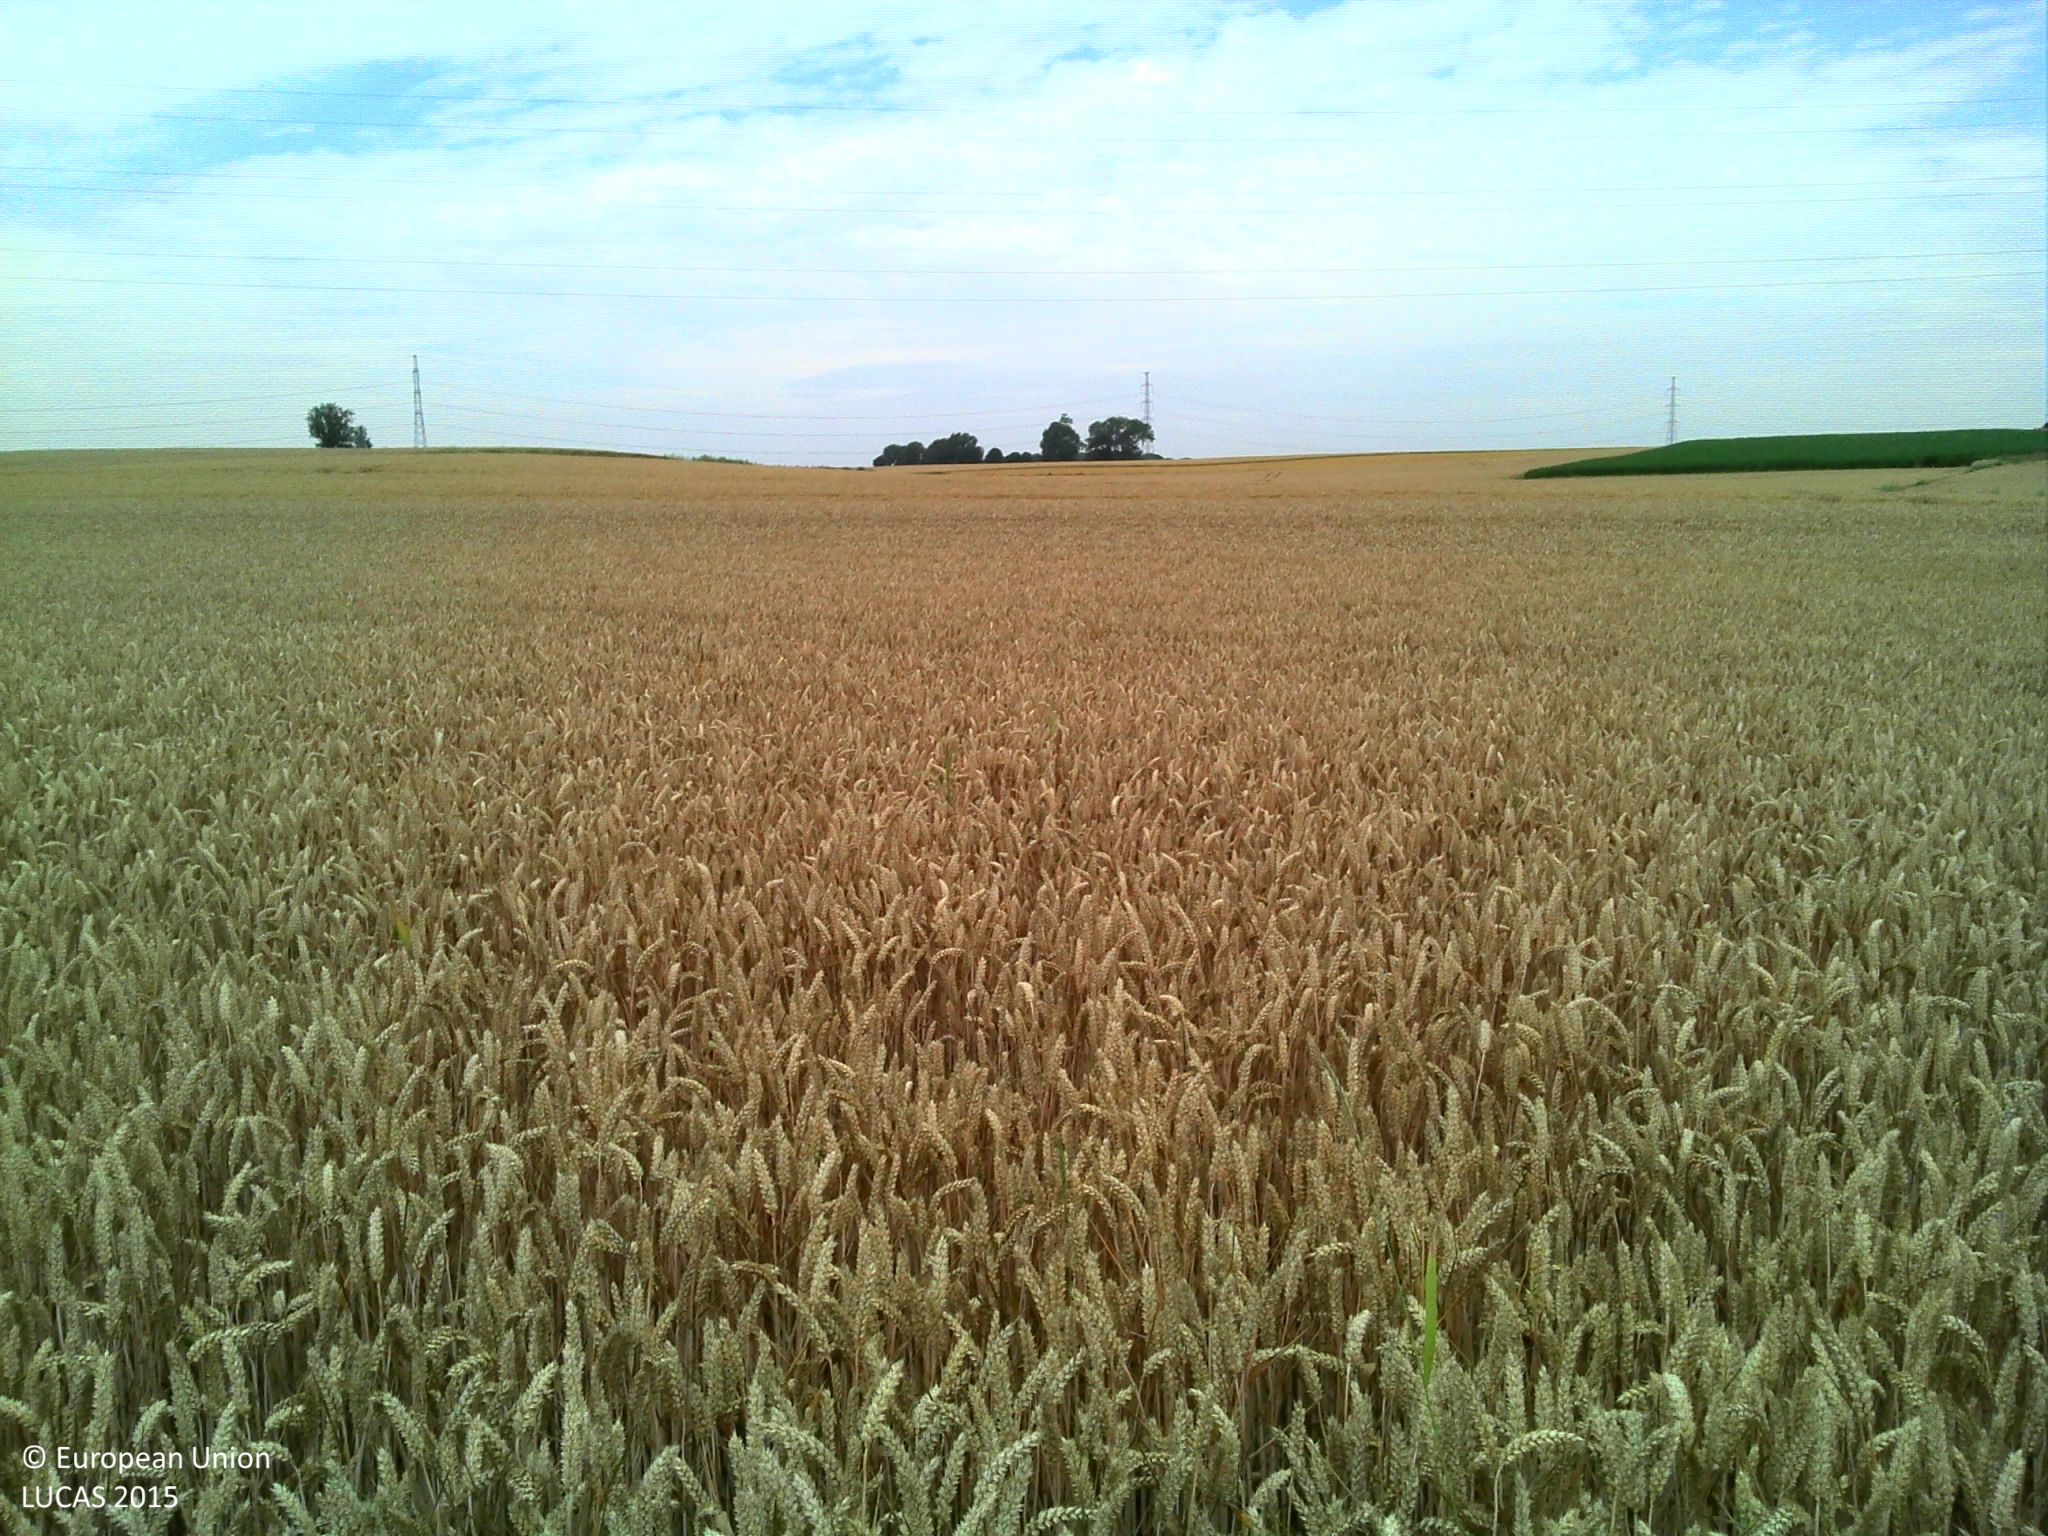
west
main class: Cropland
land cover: Common wheat
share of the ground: > 75 %
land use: Agriculture (excluding fallow land and kitchen gardens)
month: July
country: BE
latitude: 50.5303
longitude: 4.3383
